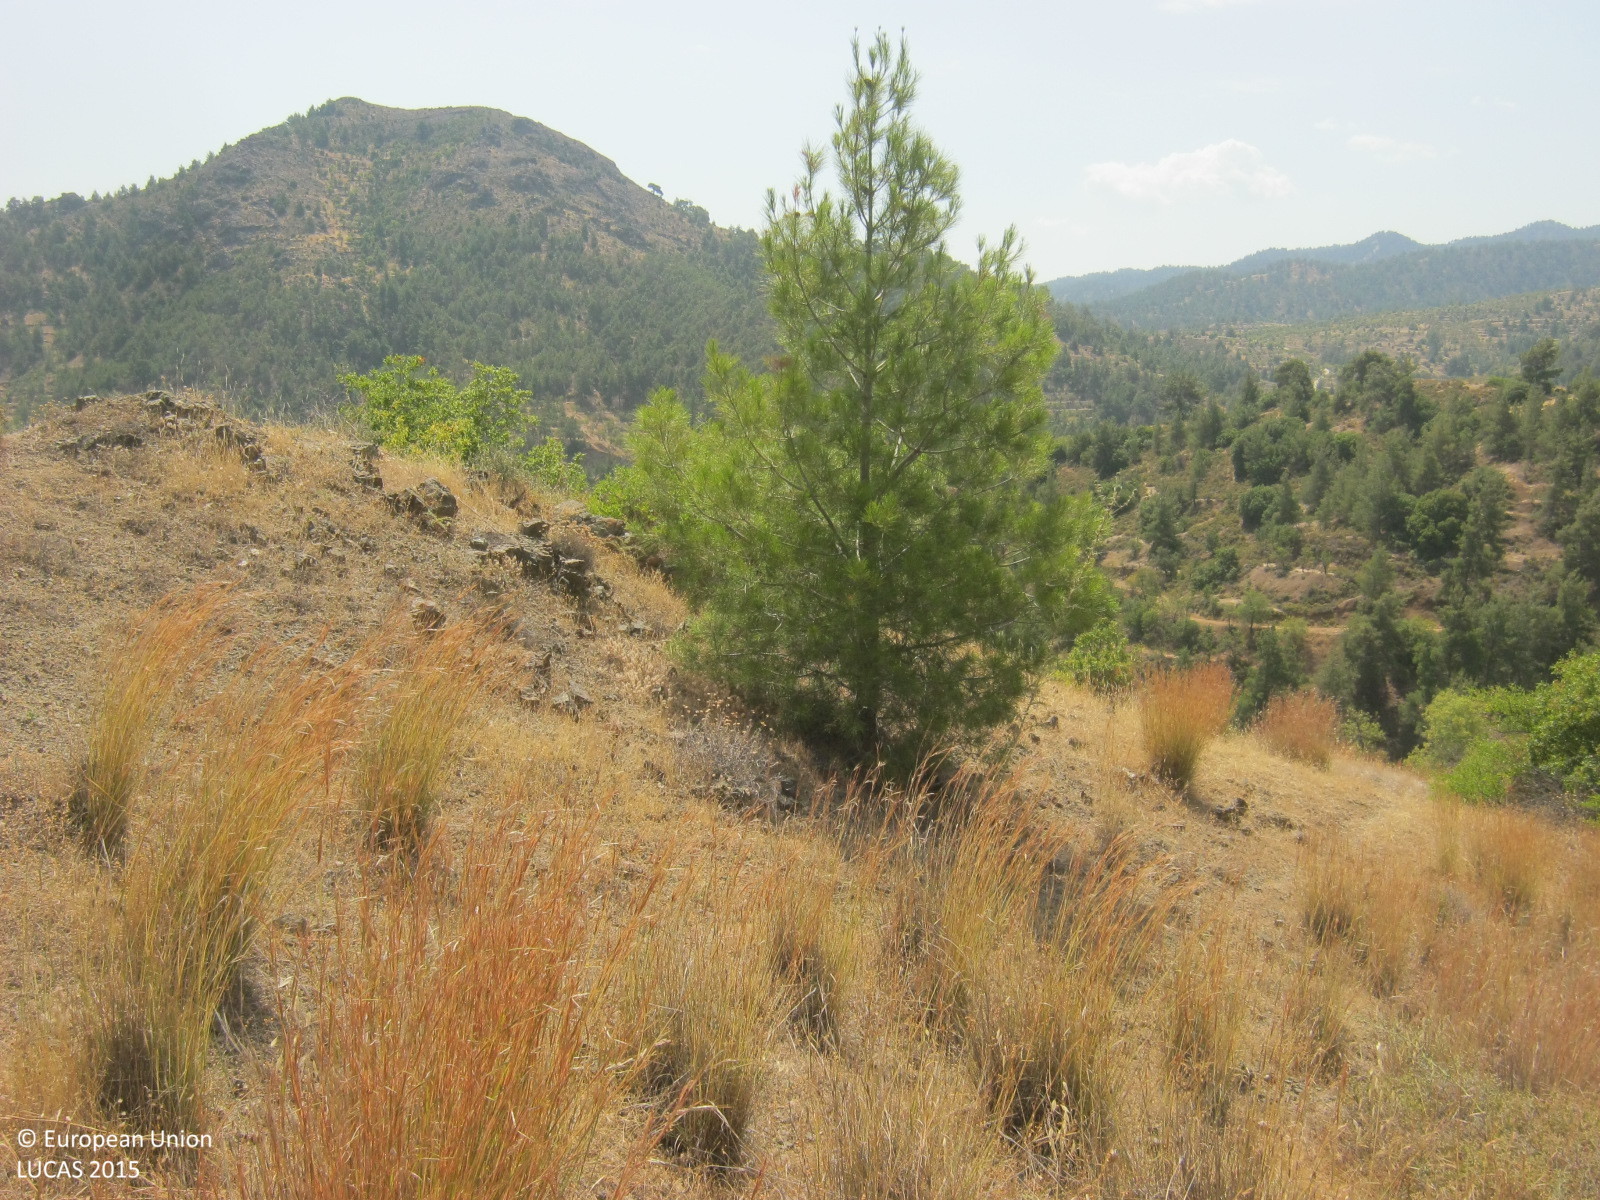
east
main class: Shrubland
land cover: Shrubland without tree cover
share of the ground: 10 - 25 %
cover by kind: herbaceous plants 70 %, shrubs 25 %, unconsolidated bare surface 5 %
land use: Semi-natural and natural areas not in use
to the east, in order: Shrubland without tree cover; Other bare soil; Nuts trees; Paved roads, cycling and walking lanes; Nuts trees; Tracks; Nuts trees; Tracks; Nuts trees; Tracks; Nuts trees
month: June
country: CY
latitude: 35.0357
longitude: 33.0082
